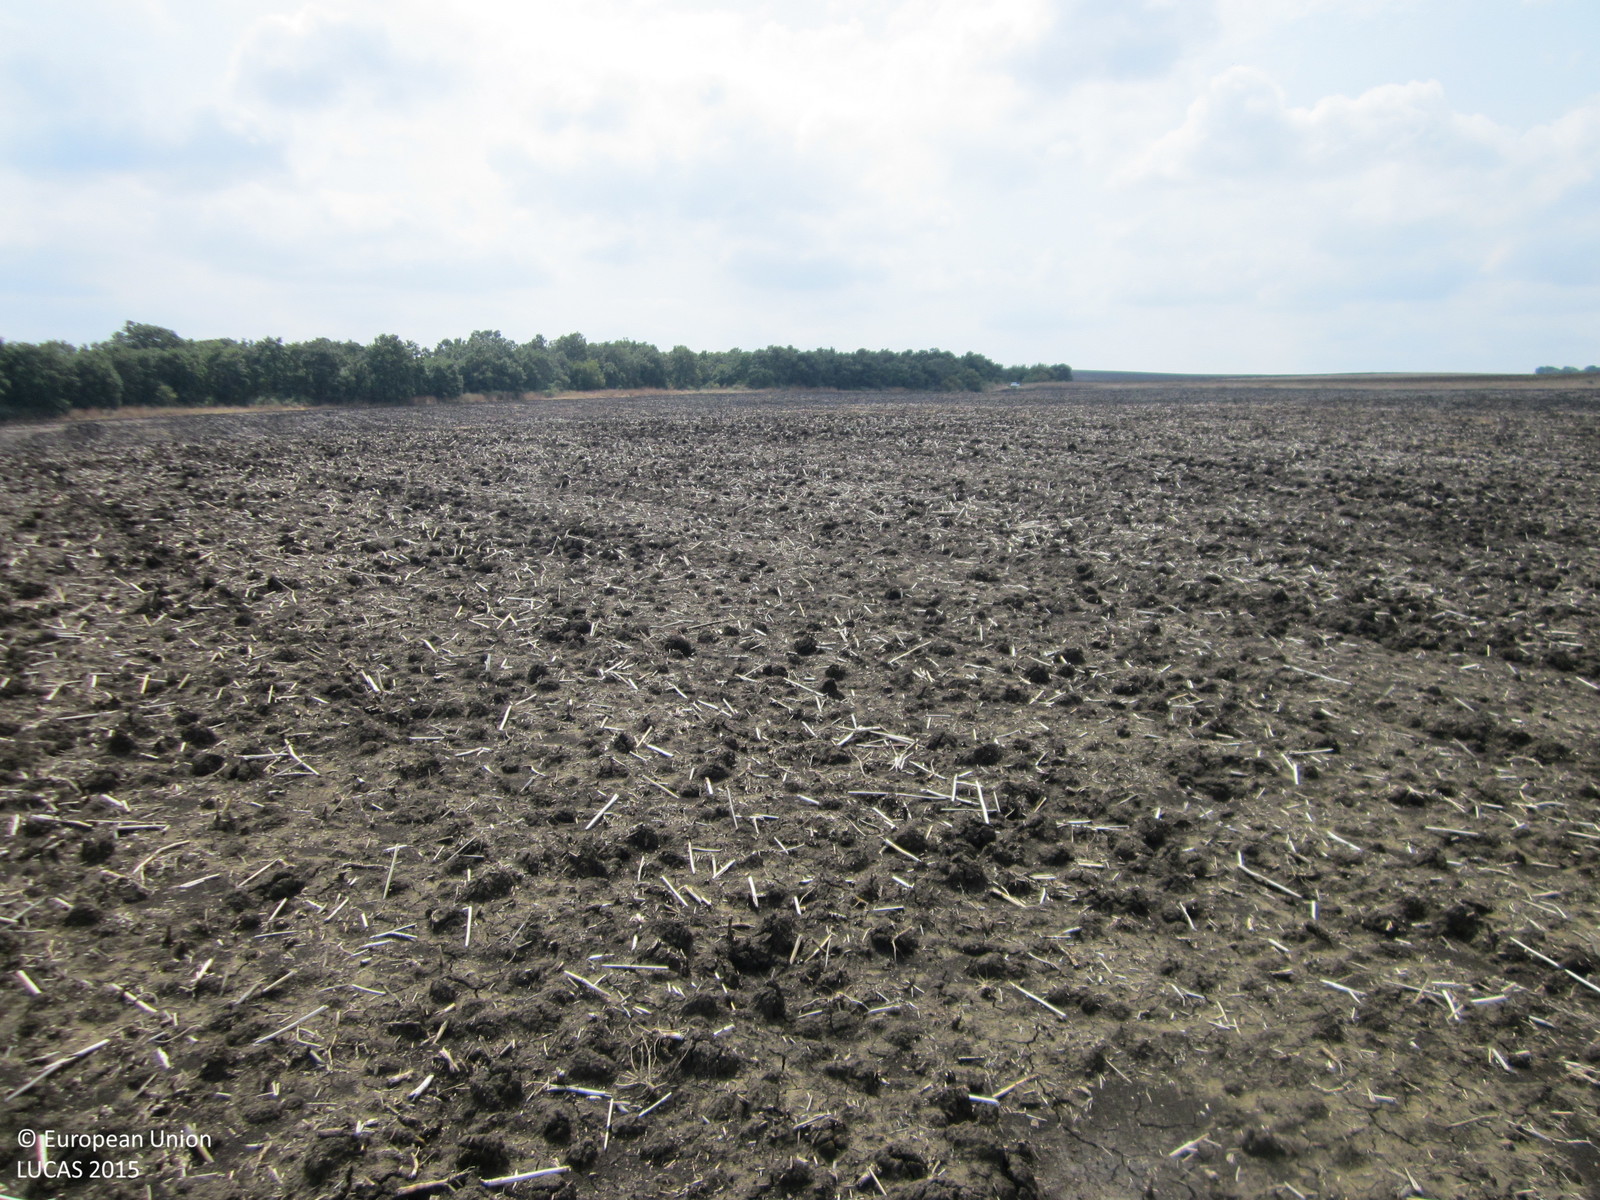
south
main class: Cropland
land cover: Sunflower
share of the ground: < 10 %
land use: Agriculture (excluding fallow land and kitchen gardens)
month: August
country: BG
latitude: 42.5048
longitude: 26.9334
